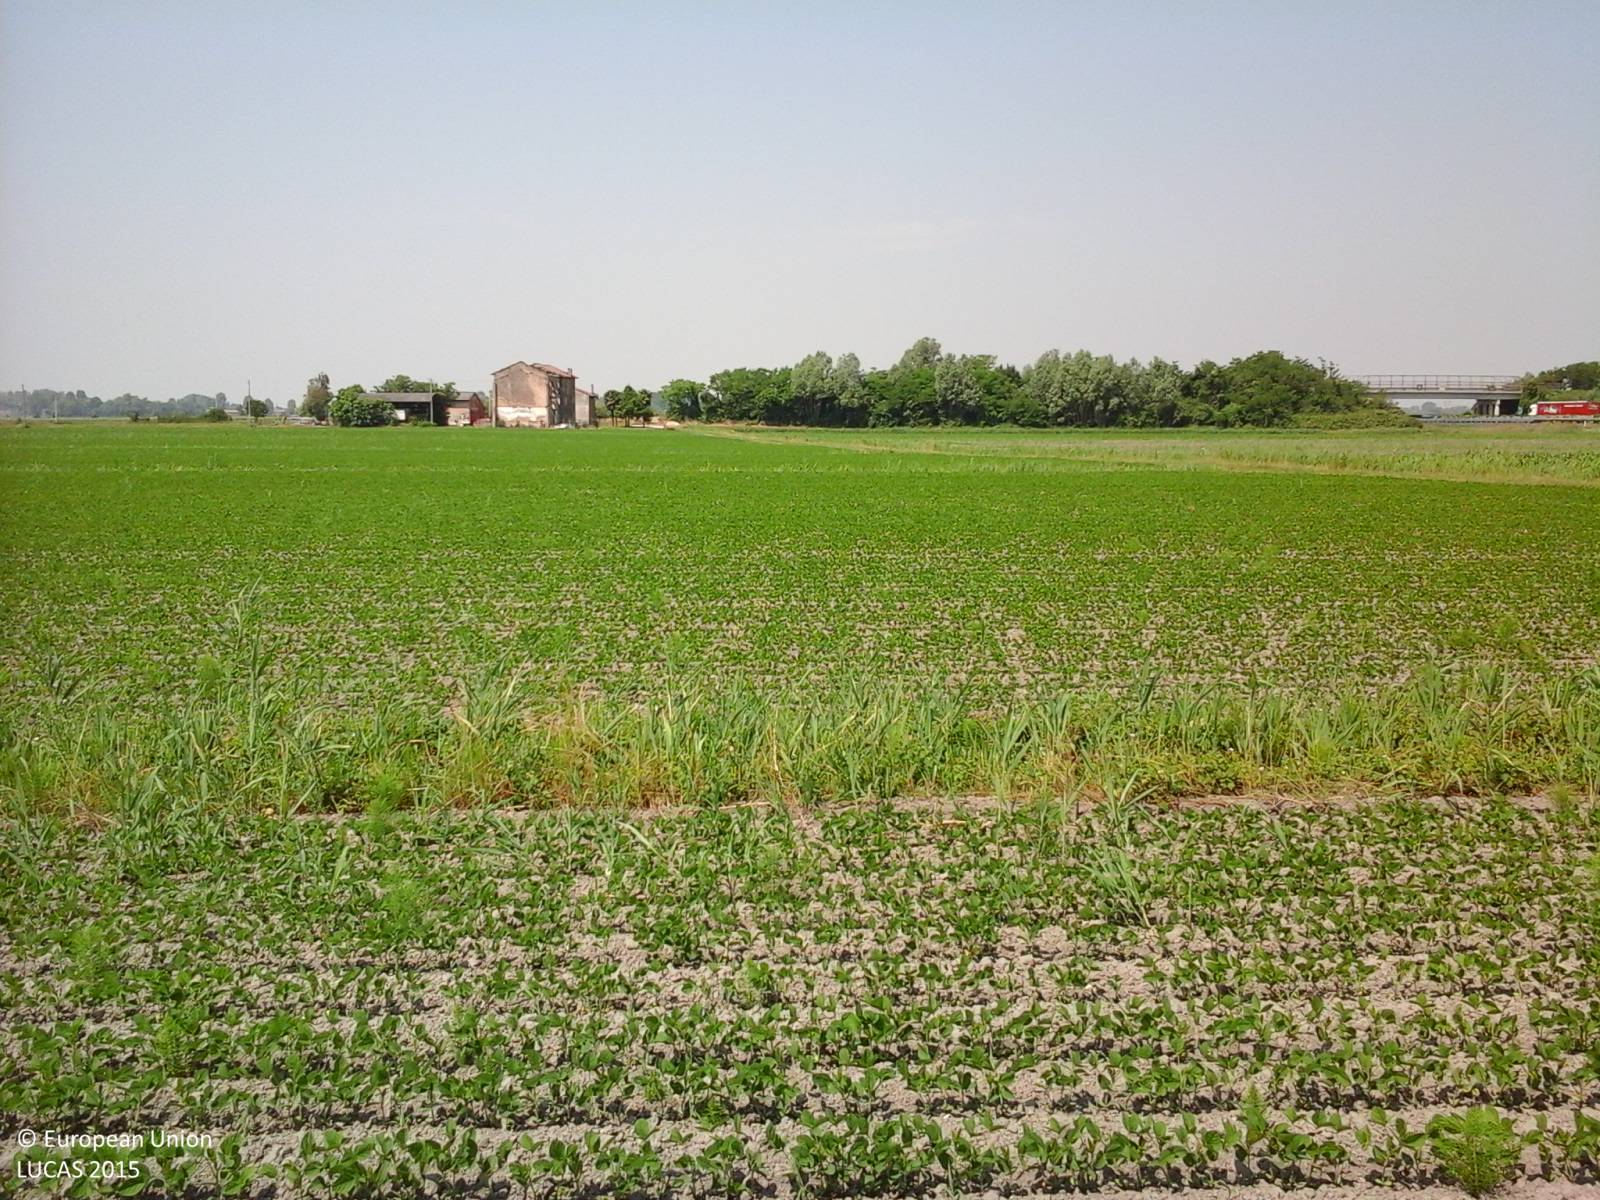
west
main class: Cropland
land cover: Soya
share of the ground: 10 - 25 %
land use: Agriculture (excluding fallow land and kitchen gardens)
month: June
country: IT
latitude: 45.8060
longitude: 12.9429
